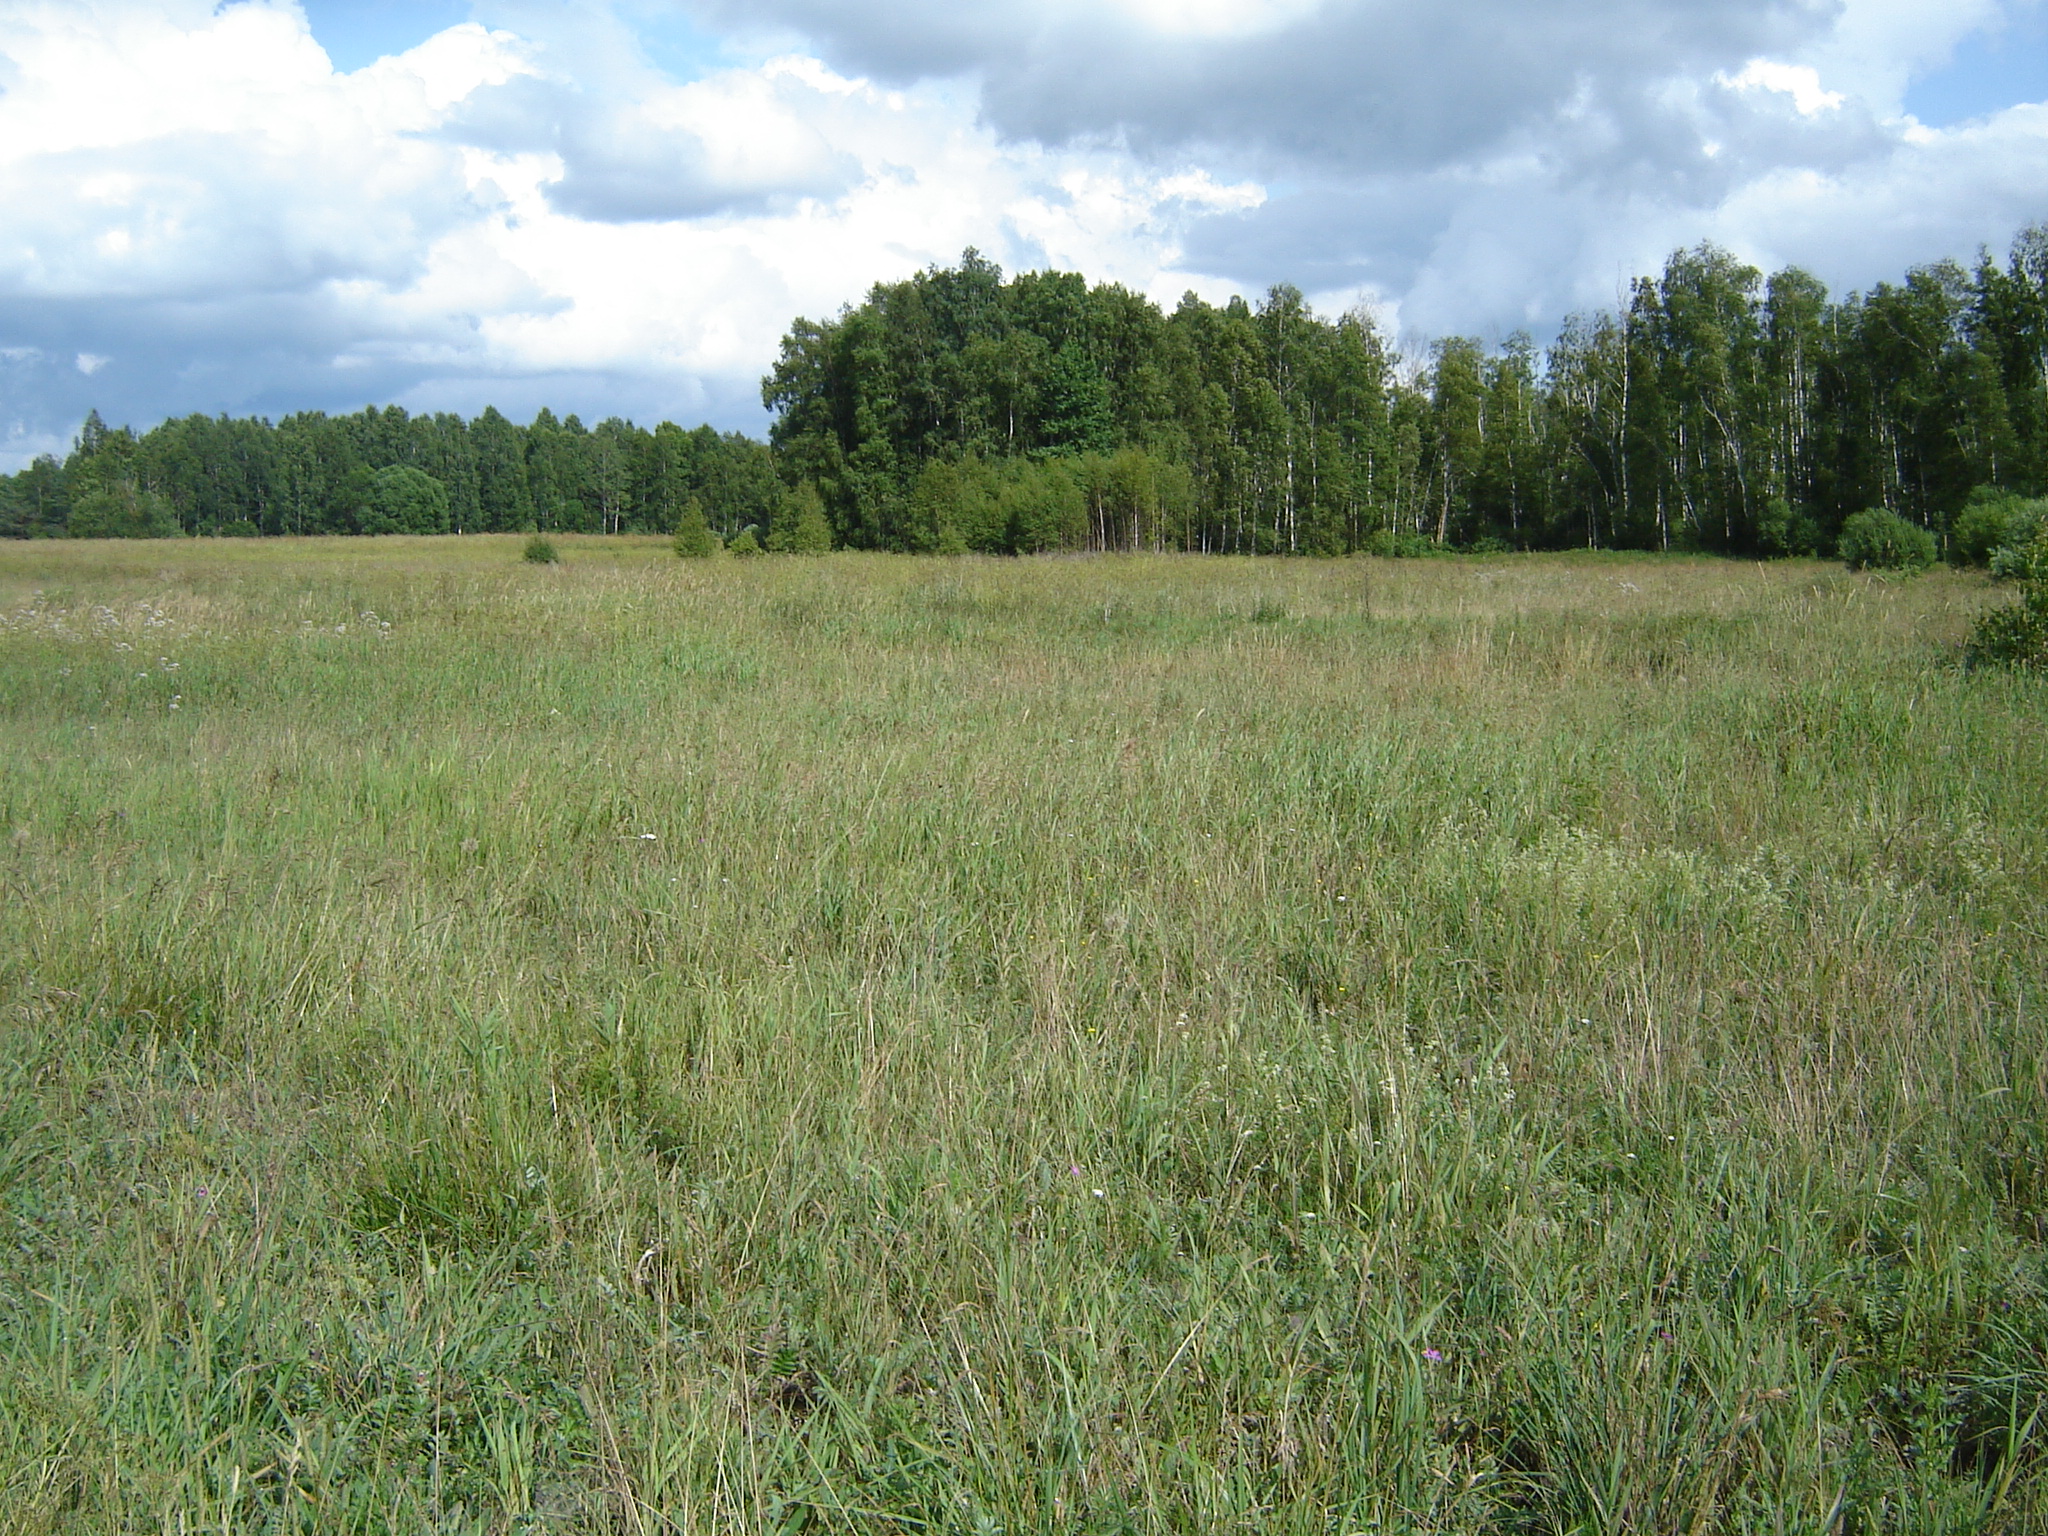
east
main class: Grassland
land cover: Grassland without tree/shrub cover
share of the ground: > 75 %
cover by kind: herbaceous plants 100 %
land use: Agriculture (excluding fallow land and kitchen gardens)
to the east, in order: Grassland without tree/shrub cover; Inland fresh running water; Grassland without tree/shrub cover; Grassland with sparse tree/shrub cover; Broadleaved woodland; Grassland without tree/shrub cover
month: July
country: LT
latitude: 55.2425
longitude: 25.4591
